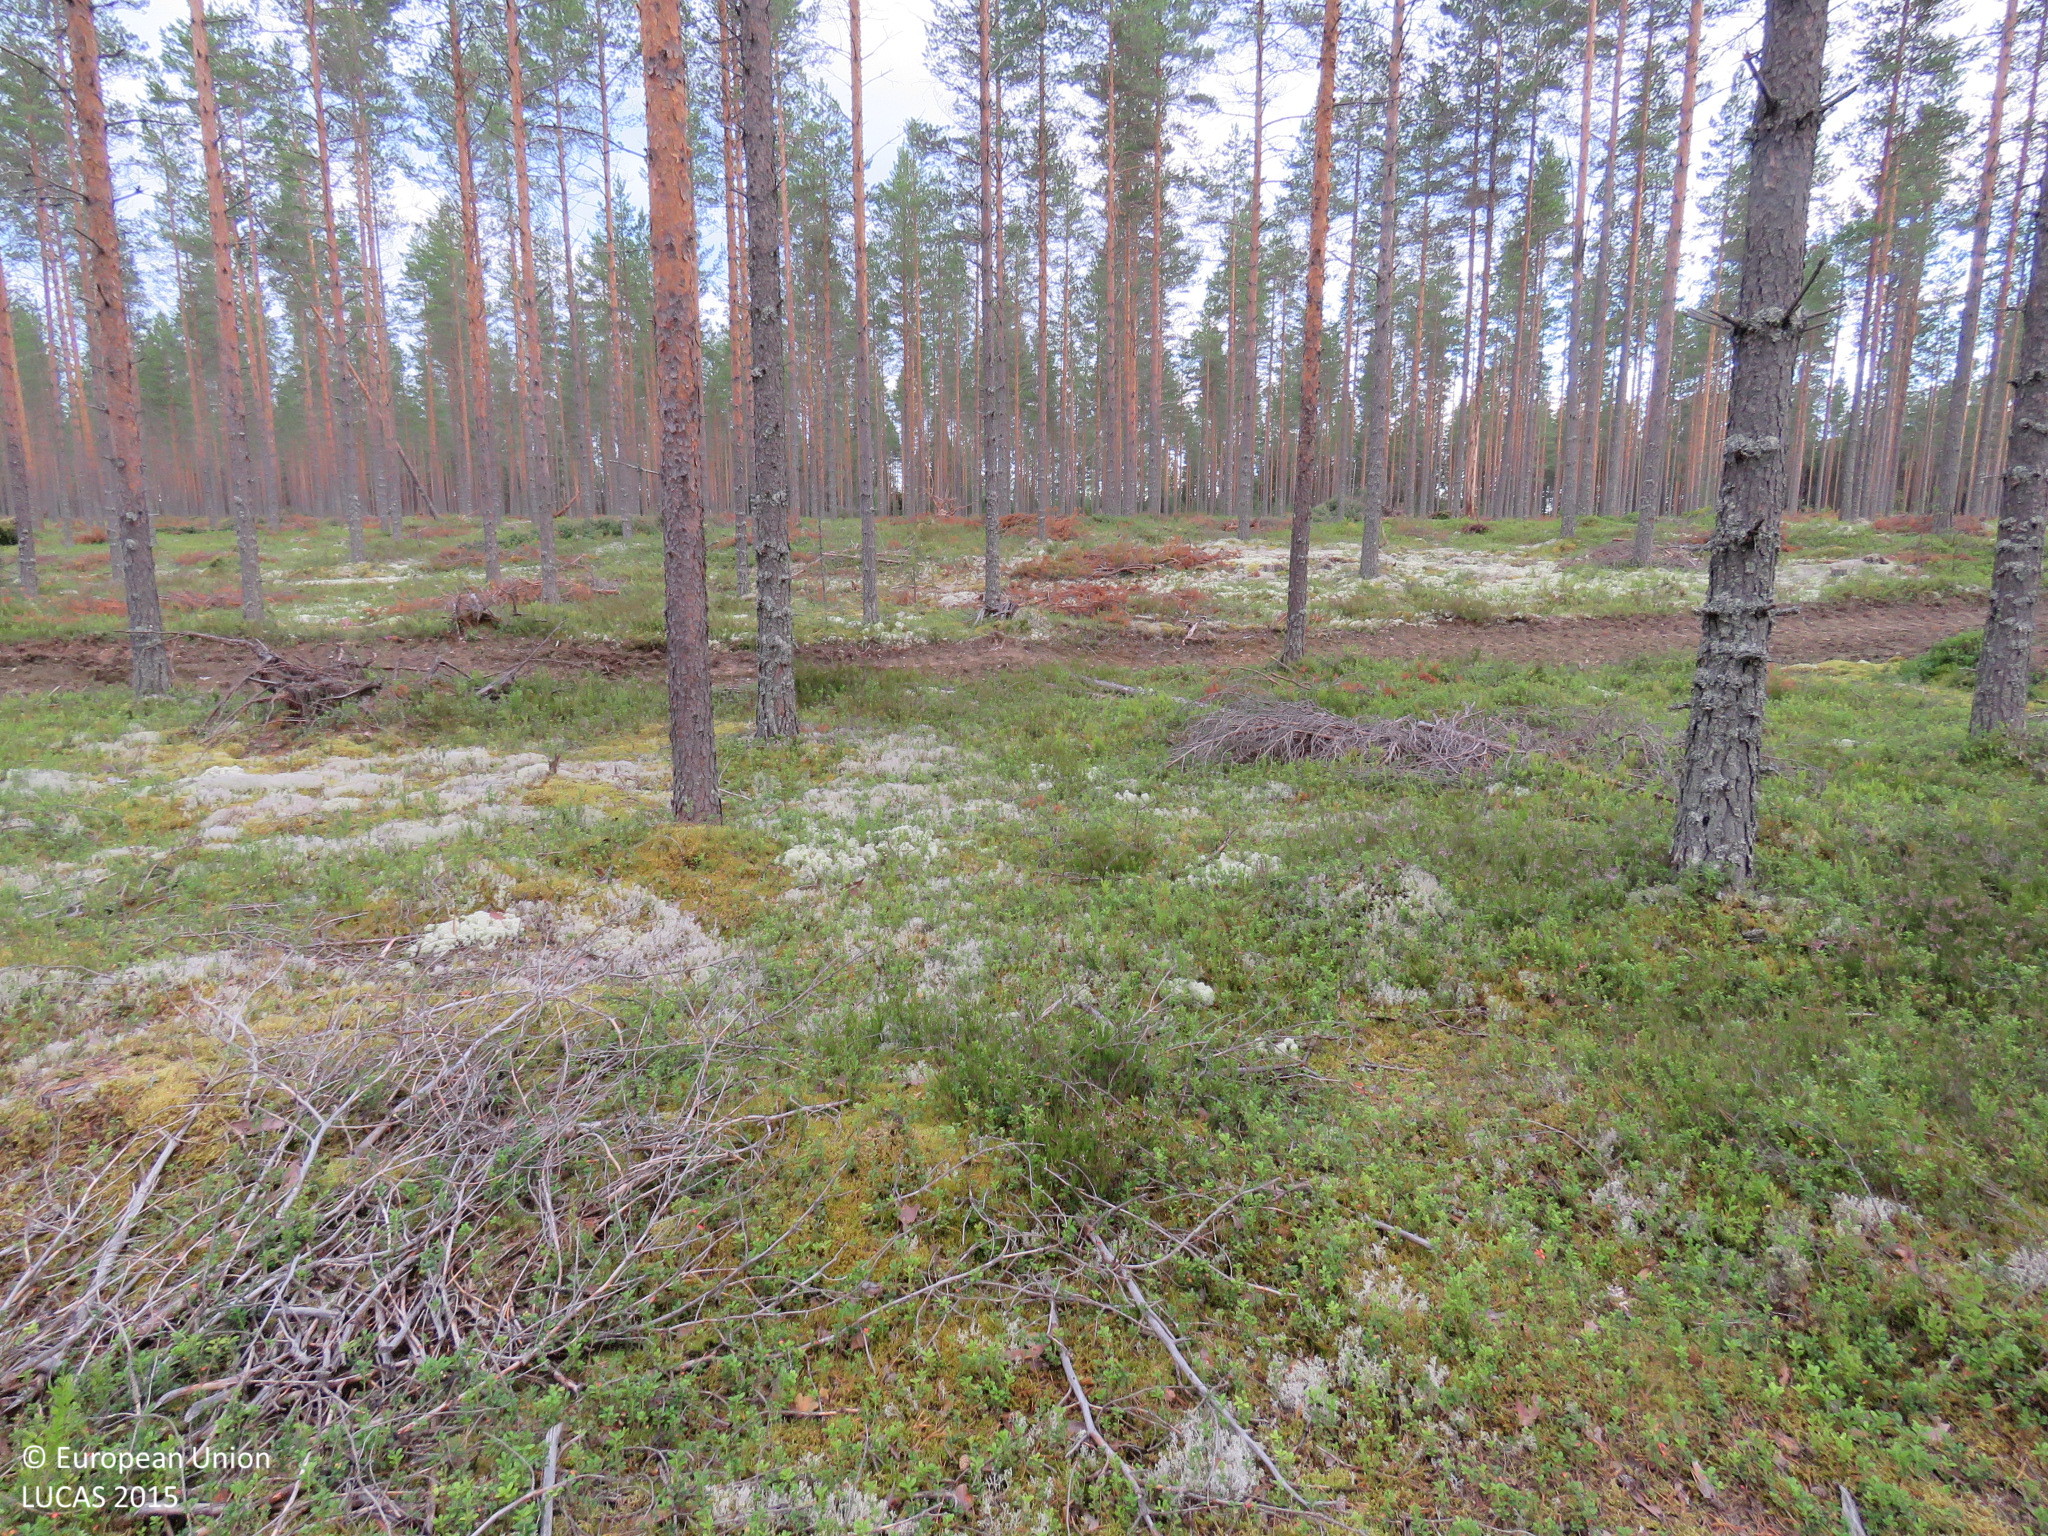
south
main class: Woodland
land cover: Pine dominated coniferous woodland
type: boreal forest
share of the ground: 50 - 75 %
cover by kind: coniferous forest trees 50 %, shrubs 40 %, lichens and mosses 10 %
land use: Forestry
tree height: > 5 m
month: July
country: FI
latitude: 64.7299
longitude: 26.5089
